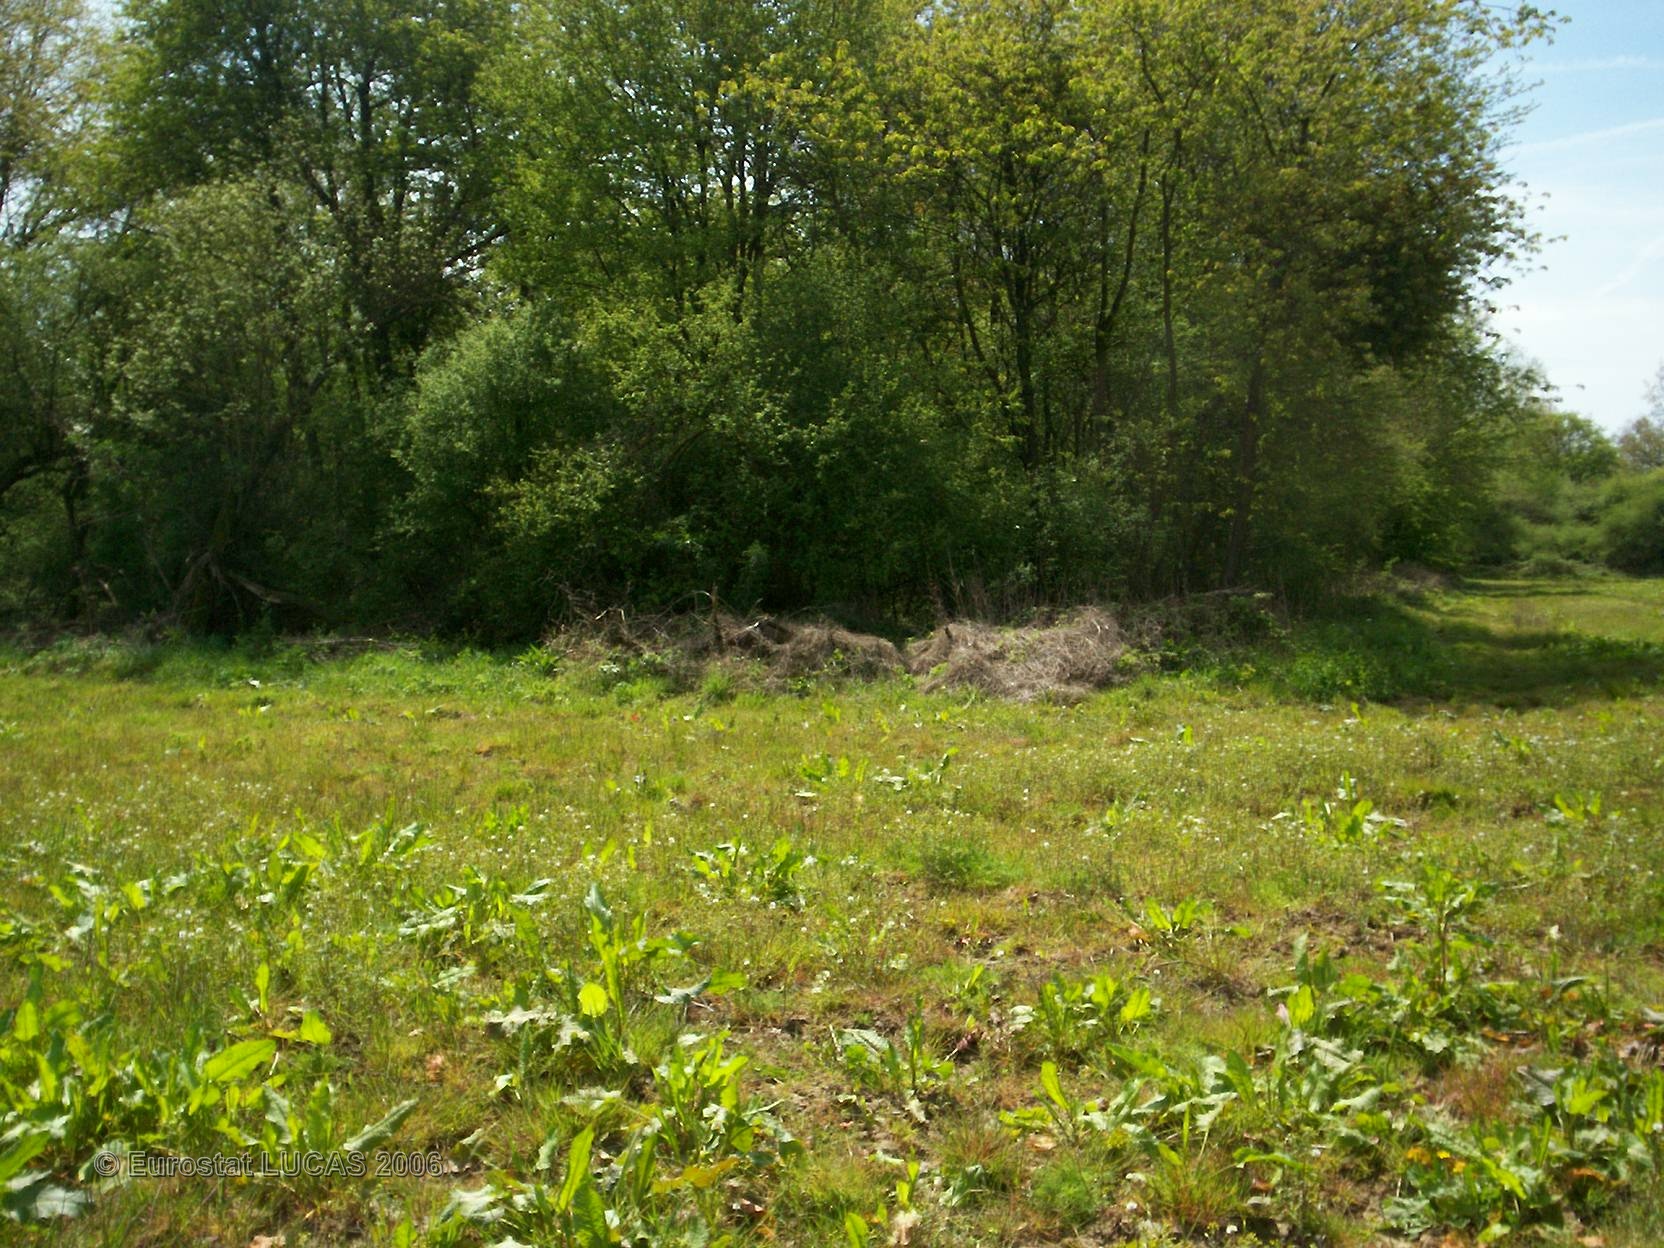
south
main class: Grassland
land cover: Grassland without tree/shrub cover
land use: Agriculture (excluding fallow land and kitchen gardens)
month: May
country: FR
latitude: 48.8197
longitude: 2.8129
